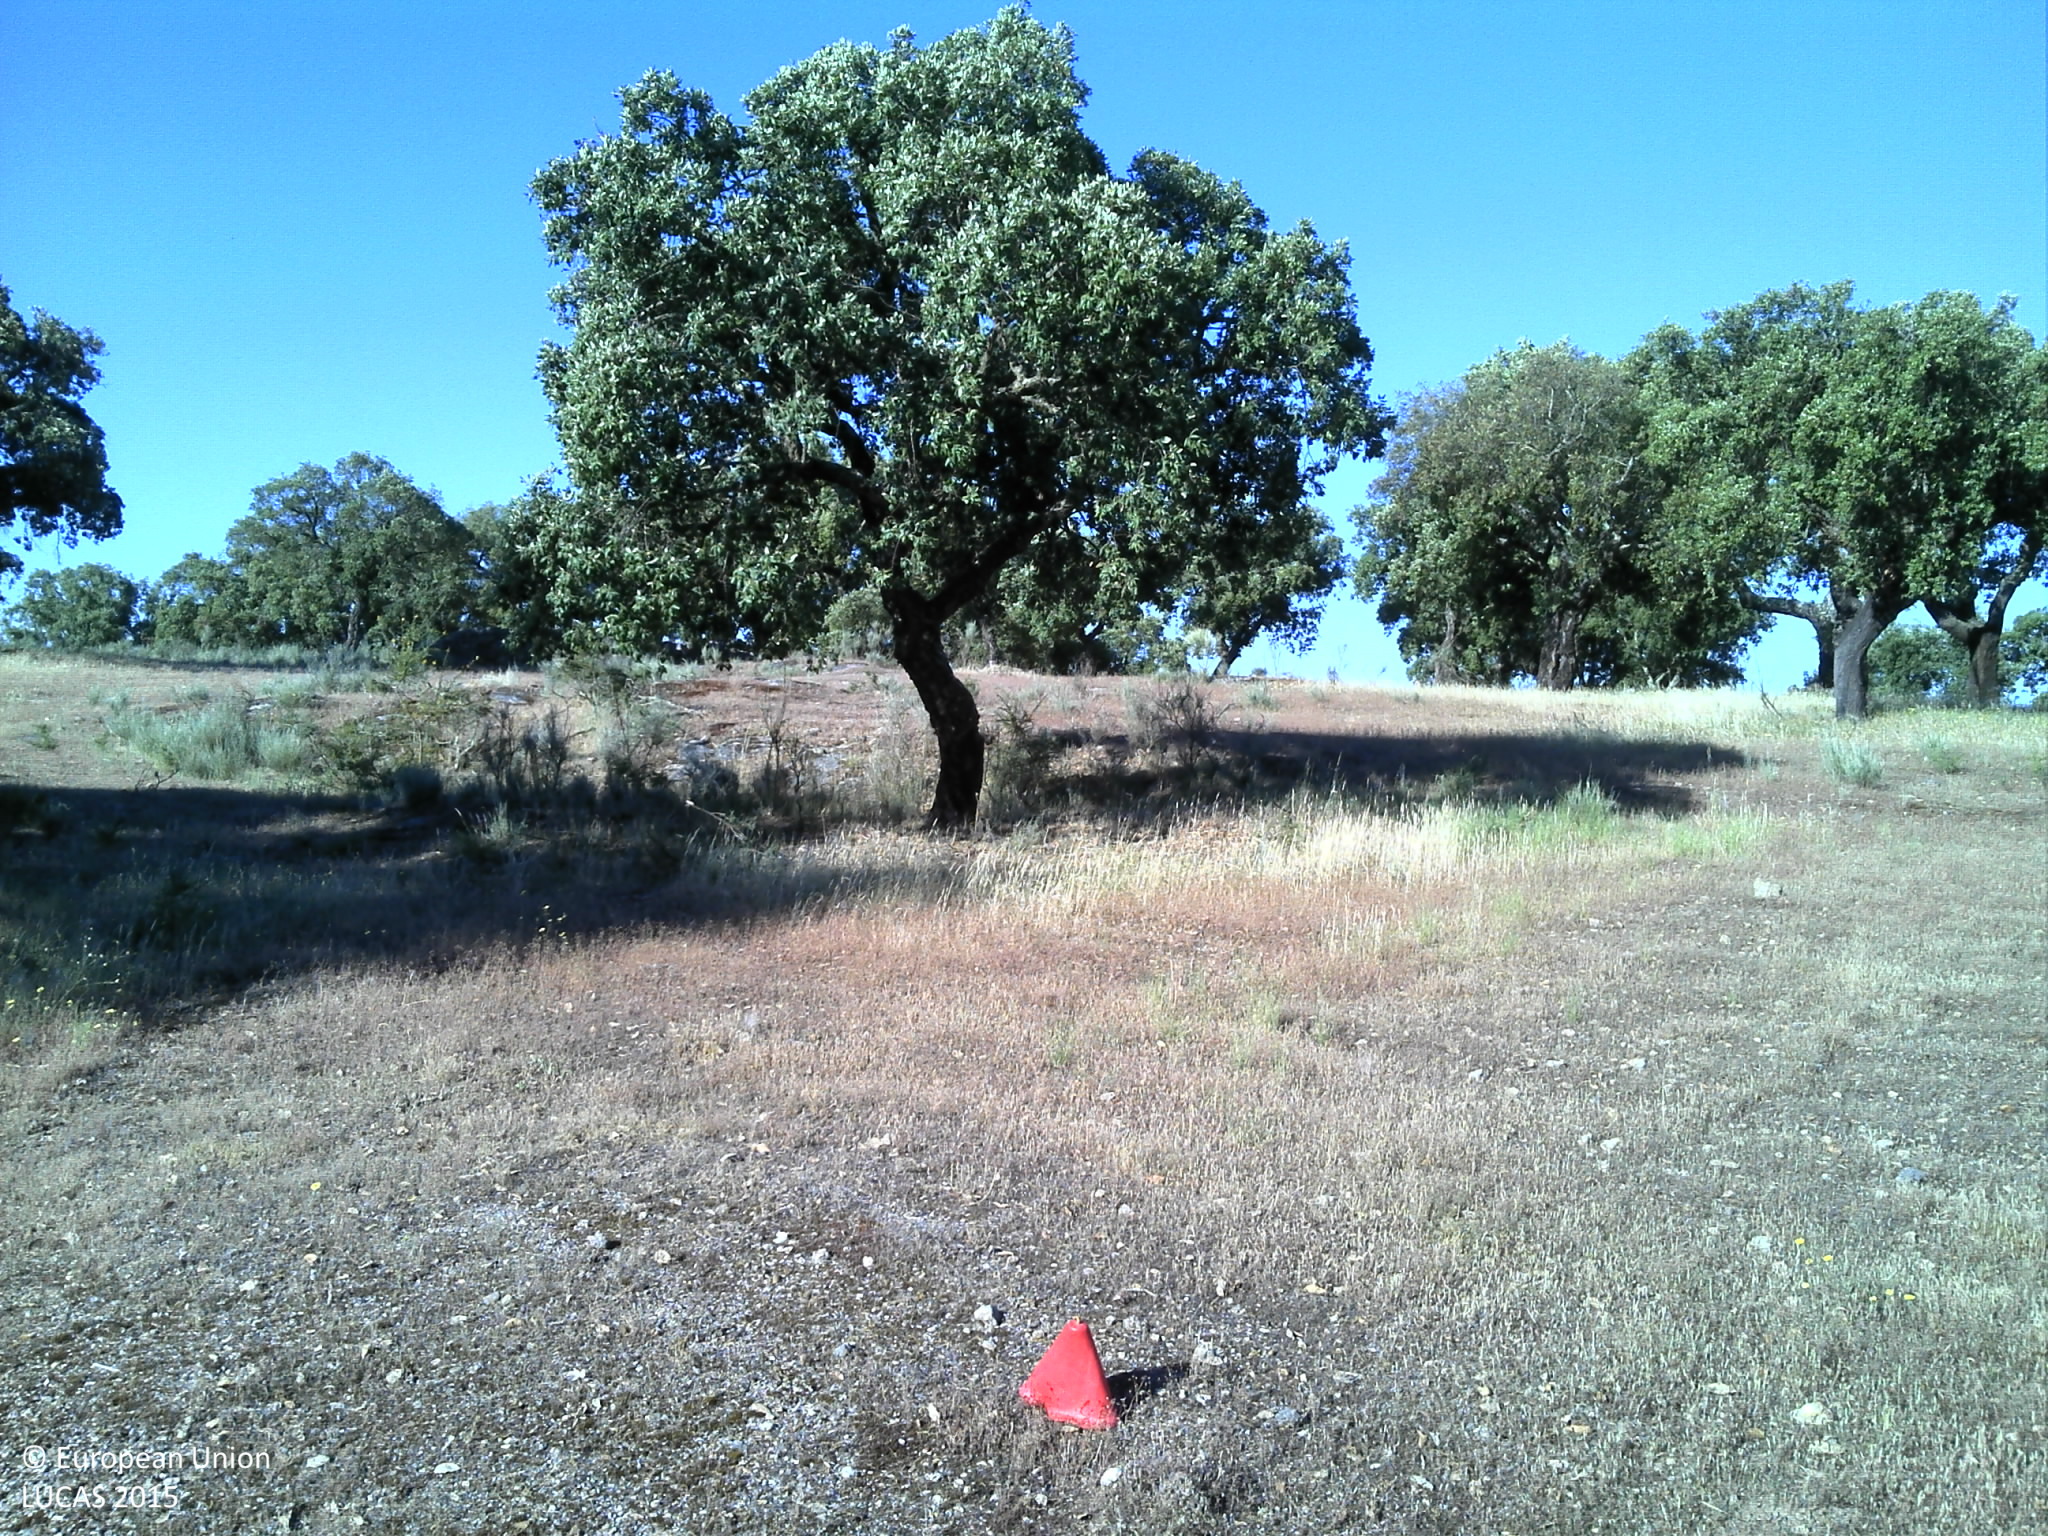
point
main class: Woodland
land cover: Broadleaved woodland
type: broadleaved evergreen forest
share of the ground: 10 - 25 %
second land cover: Grassland without tree/shrub cover
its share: 25 - 50 %
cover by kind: herbaceous plants 50 %, unconsolidated bare surface 30 %, broadleaved forest trees 20 %
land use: Forestry
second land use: Agriculture (excluding fallow land and kitchen gardens)
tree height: > 5 m
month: May
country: PT
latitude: 39.4194
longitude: -7.5988
